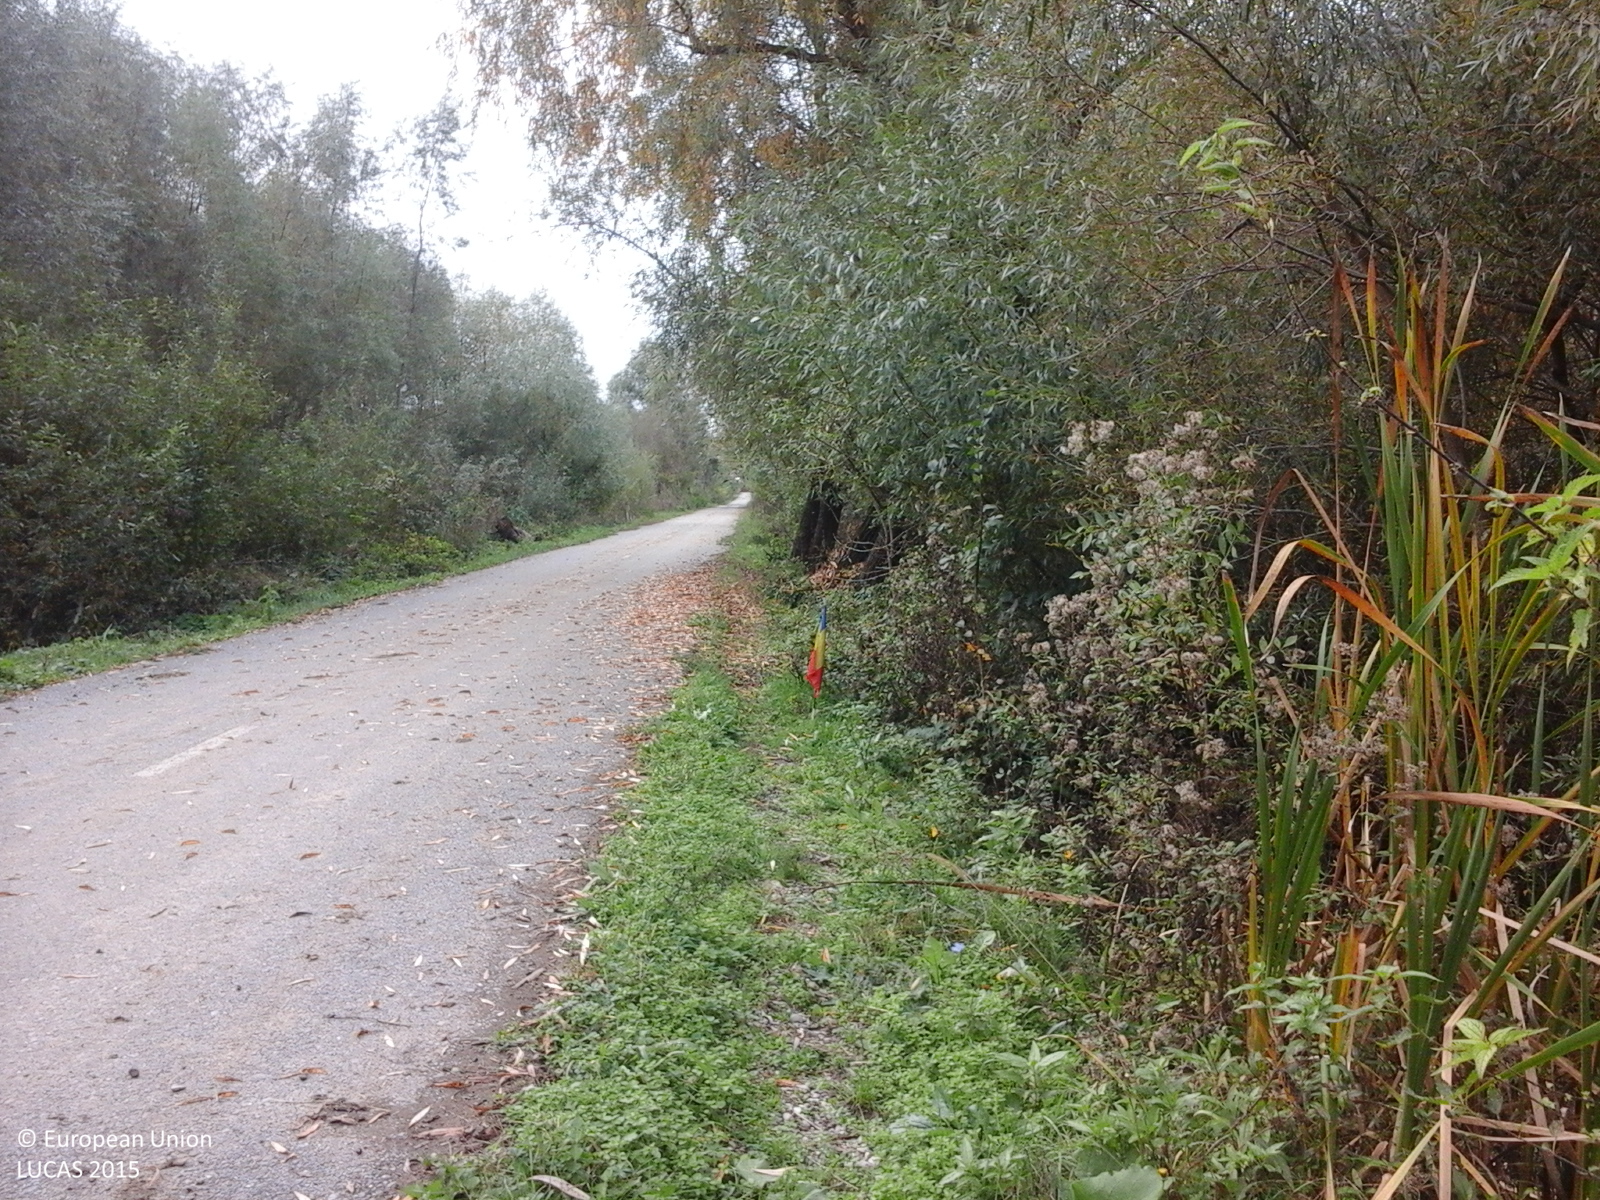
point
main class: Woodland
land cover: Broadleaved woodland
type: mesophytic deciduous forest
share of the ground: > 75 %
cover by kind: broadleaved forest trees 100 %
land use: Semi-natural and natural areas not in use
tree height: > 5 m
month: October
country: RO
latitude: 44.7660
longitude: 26.1427
